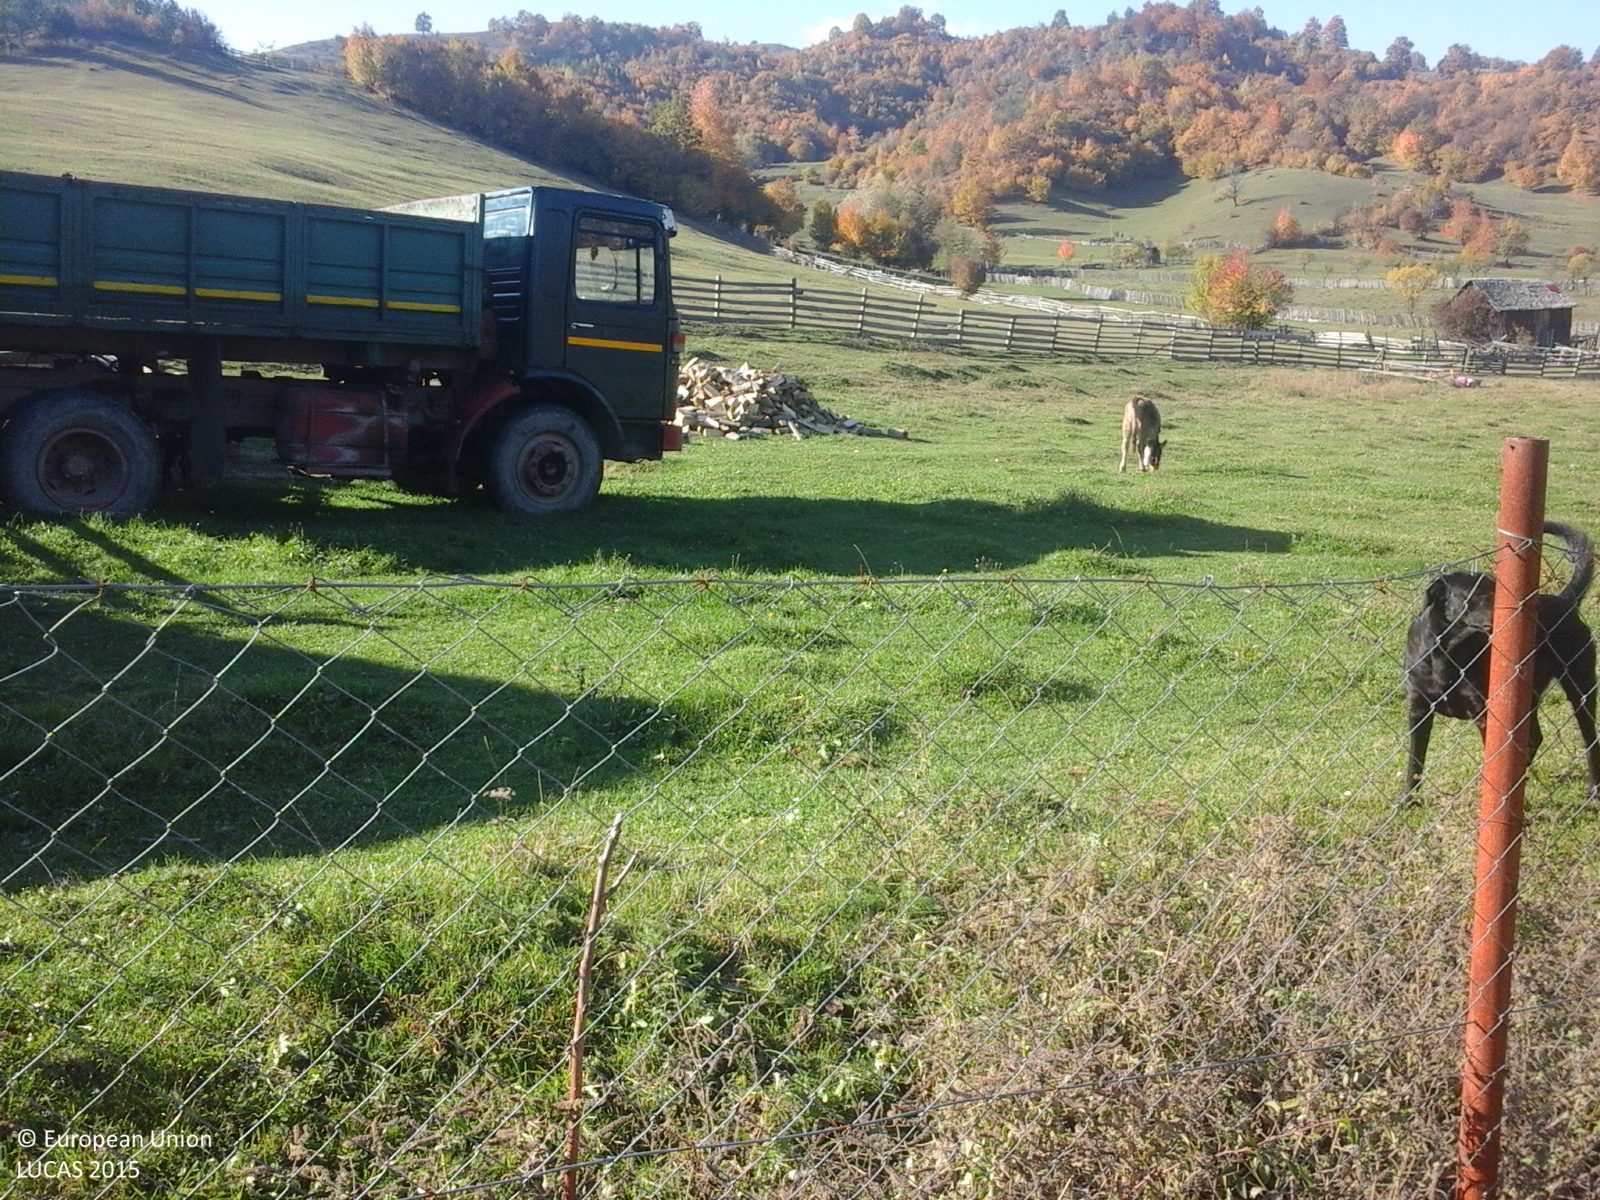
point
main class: Grassland
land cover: Grassland without tree/shrub cover
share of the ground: > 75 %
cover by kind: herbaceous plants 100 %
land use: Residential
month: October
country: RO
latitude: 45.9301
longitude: 26.6800
